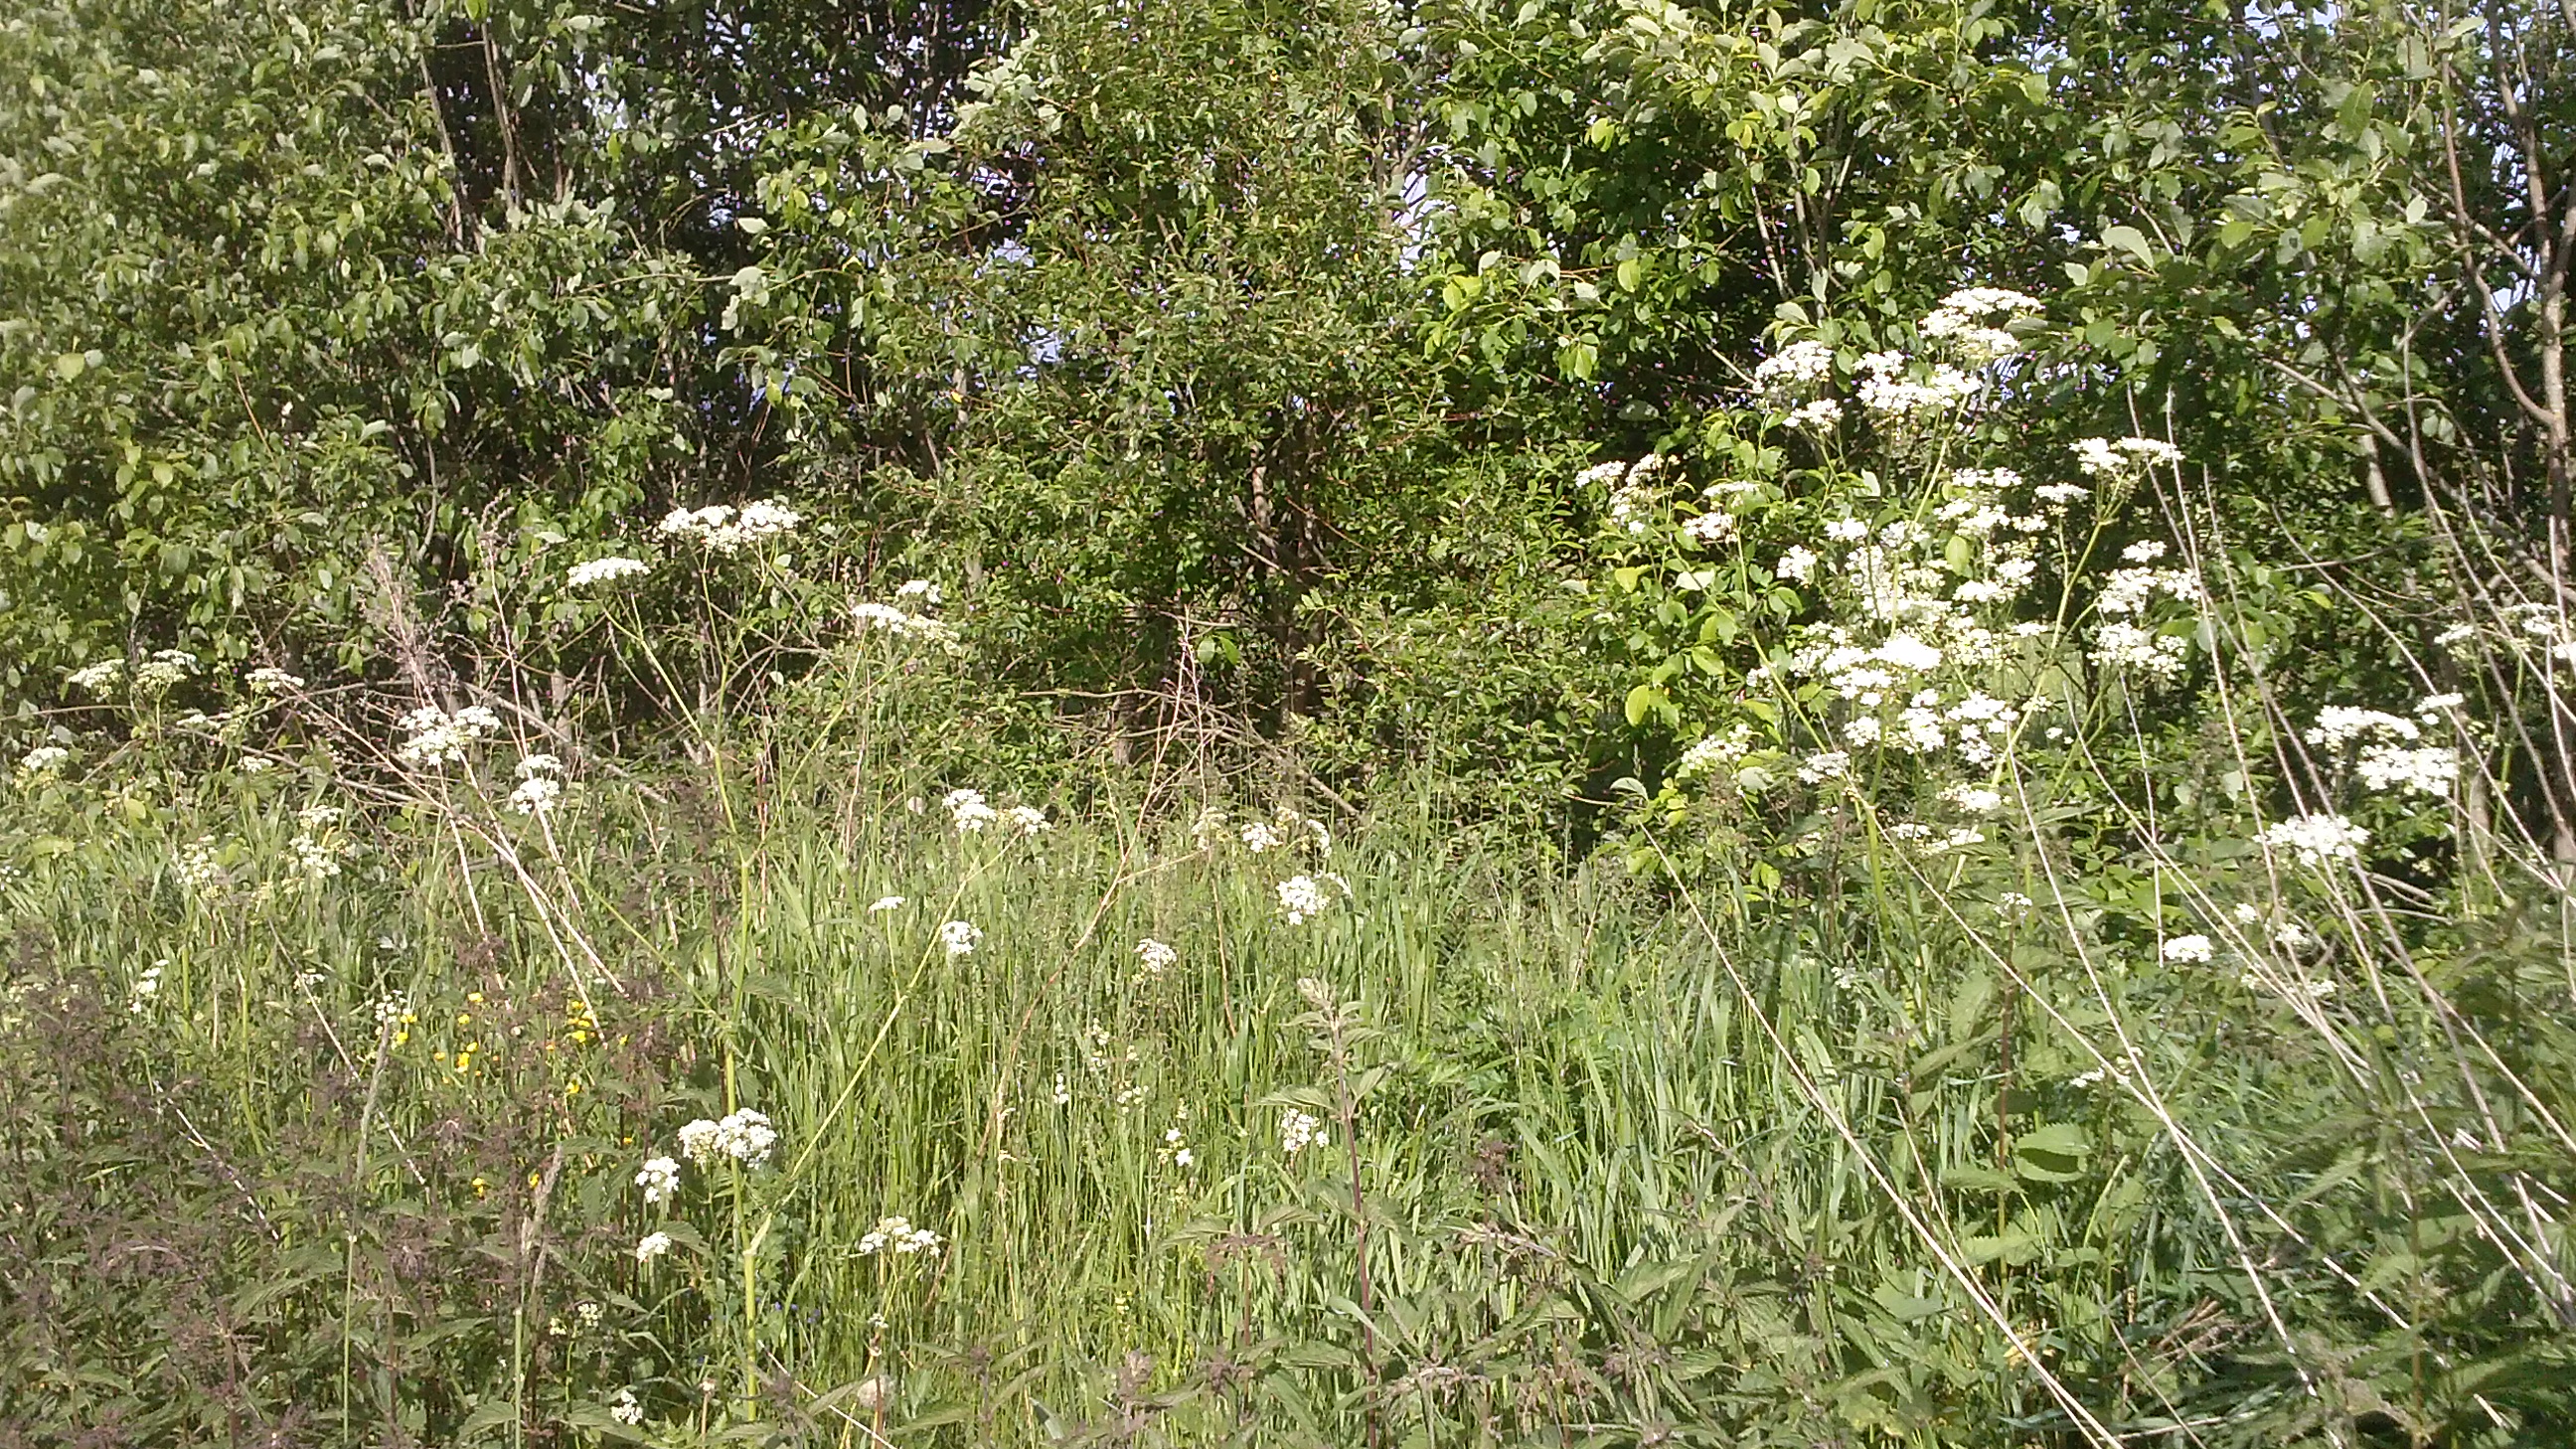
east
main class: Grassland
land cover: Spontaneously vegetated surfaces
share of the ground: > 75 %
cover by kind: herbaceous plants 95 %, shrubs 5 %
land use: Semi-natural and natural areas not in use
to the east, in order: Spontaneously vegetated surfaces; Broadleaved woodland; Ditches and canals; Shrubland without tree cover; Grassland without tree/shrub cover; Tracks; Grass margins; Barley; Grassland without tree/shrub cover; Paved roads, cycling and walking lanes; Grassland without tree/shrub cover; Barley; Broadleaved woodland; Artificial constructions in urban areas; Grassland without tree/shrub cover
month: June
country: LV
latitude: 56.4703
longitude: 27.4660
